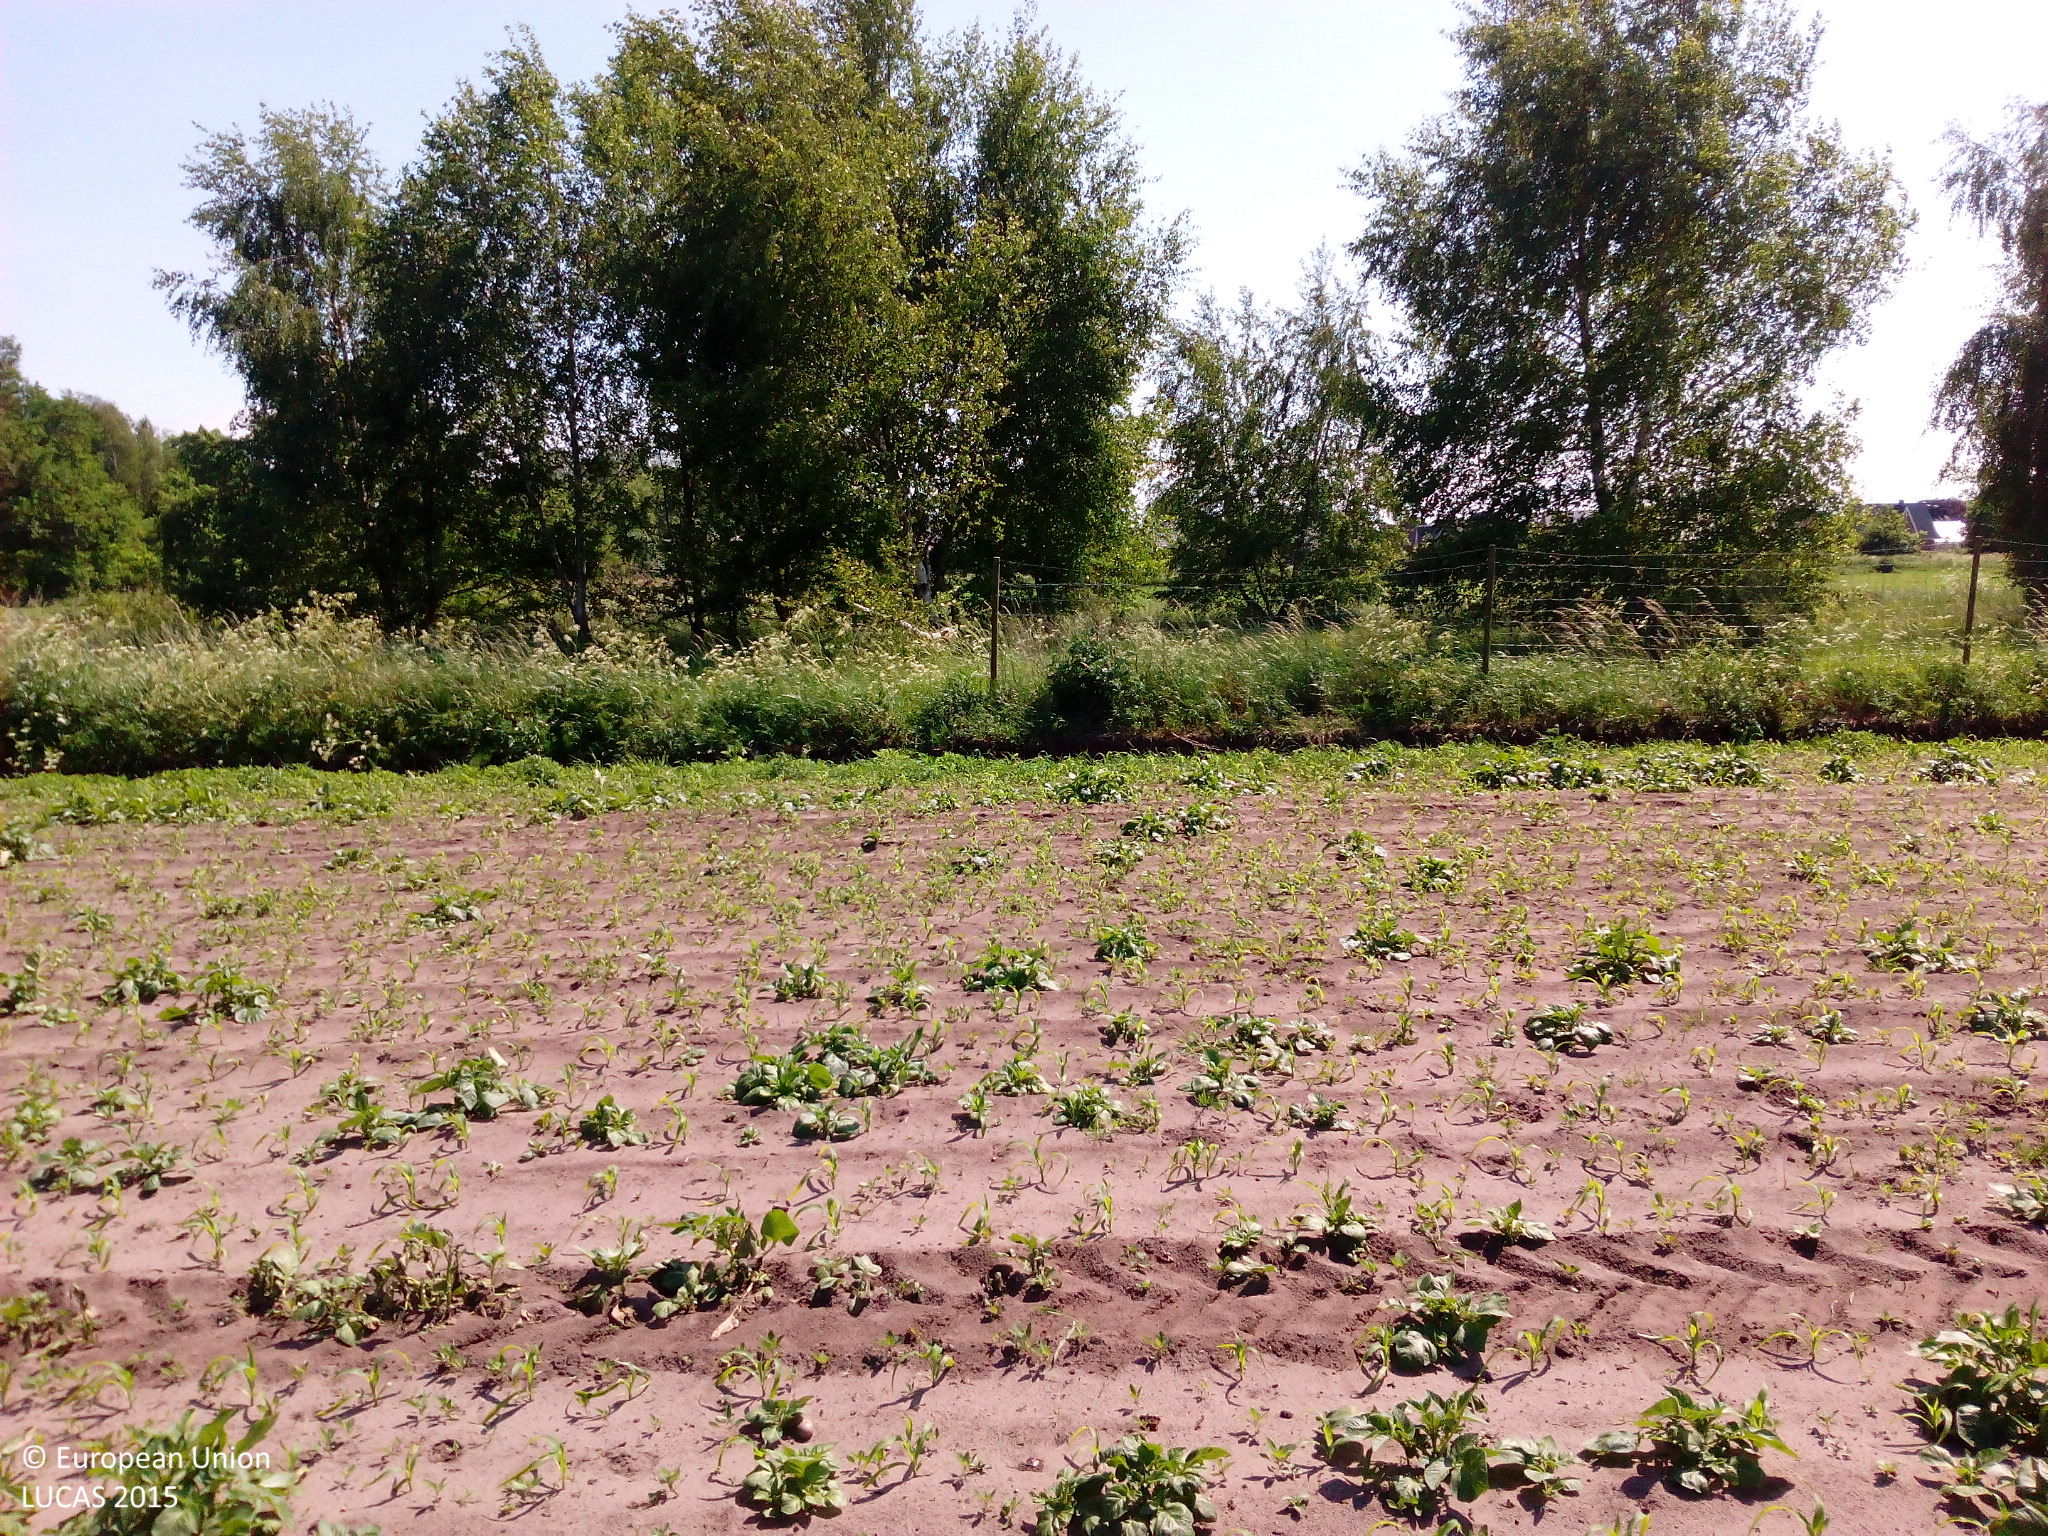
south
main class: Cropland
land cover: Maize
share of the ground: 10 - 25 %
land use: Agriculture (excluding fallow land and kitchen gardens)
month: June
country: DE
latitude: 53.7069
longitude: 9.6518
